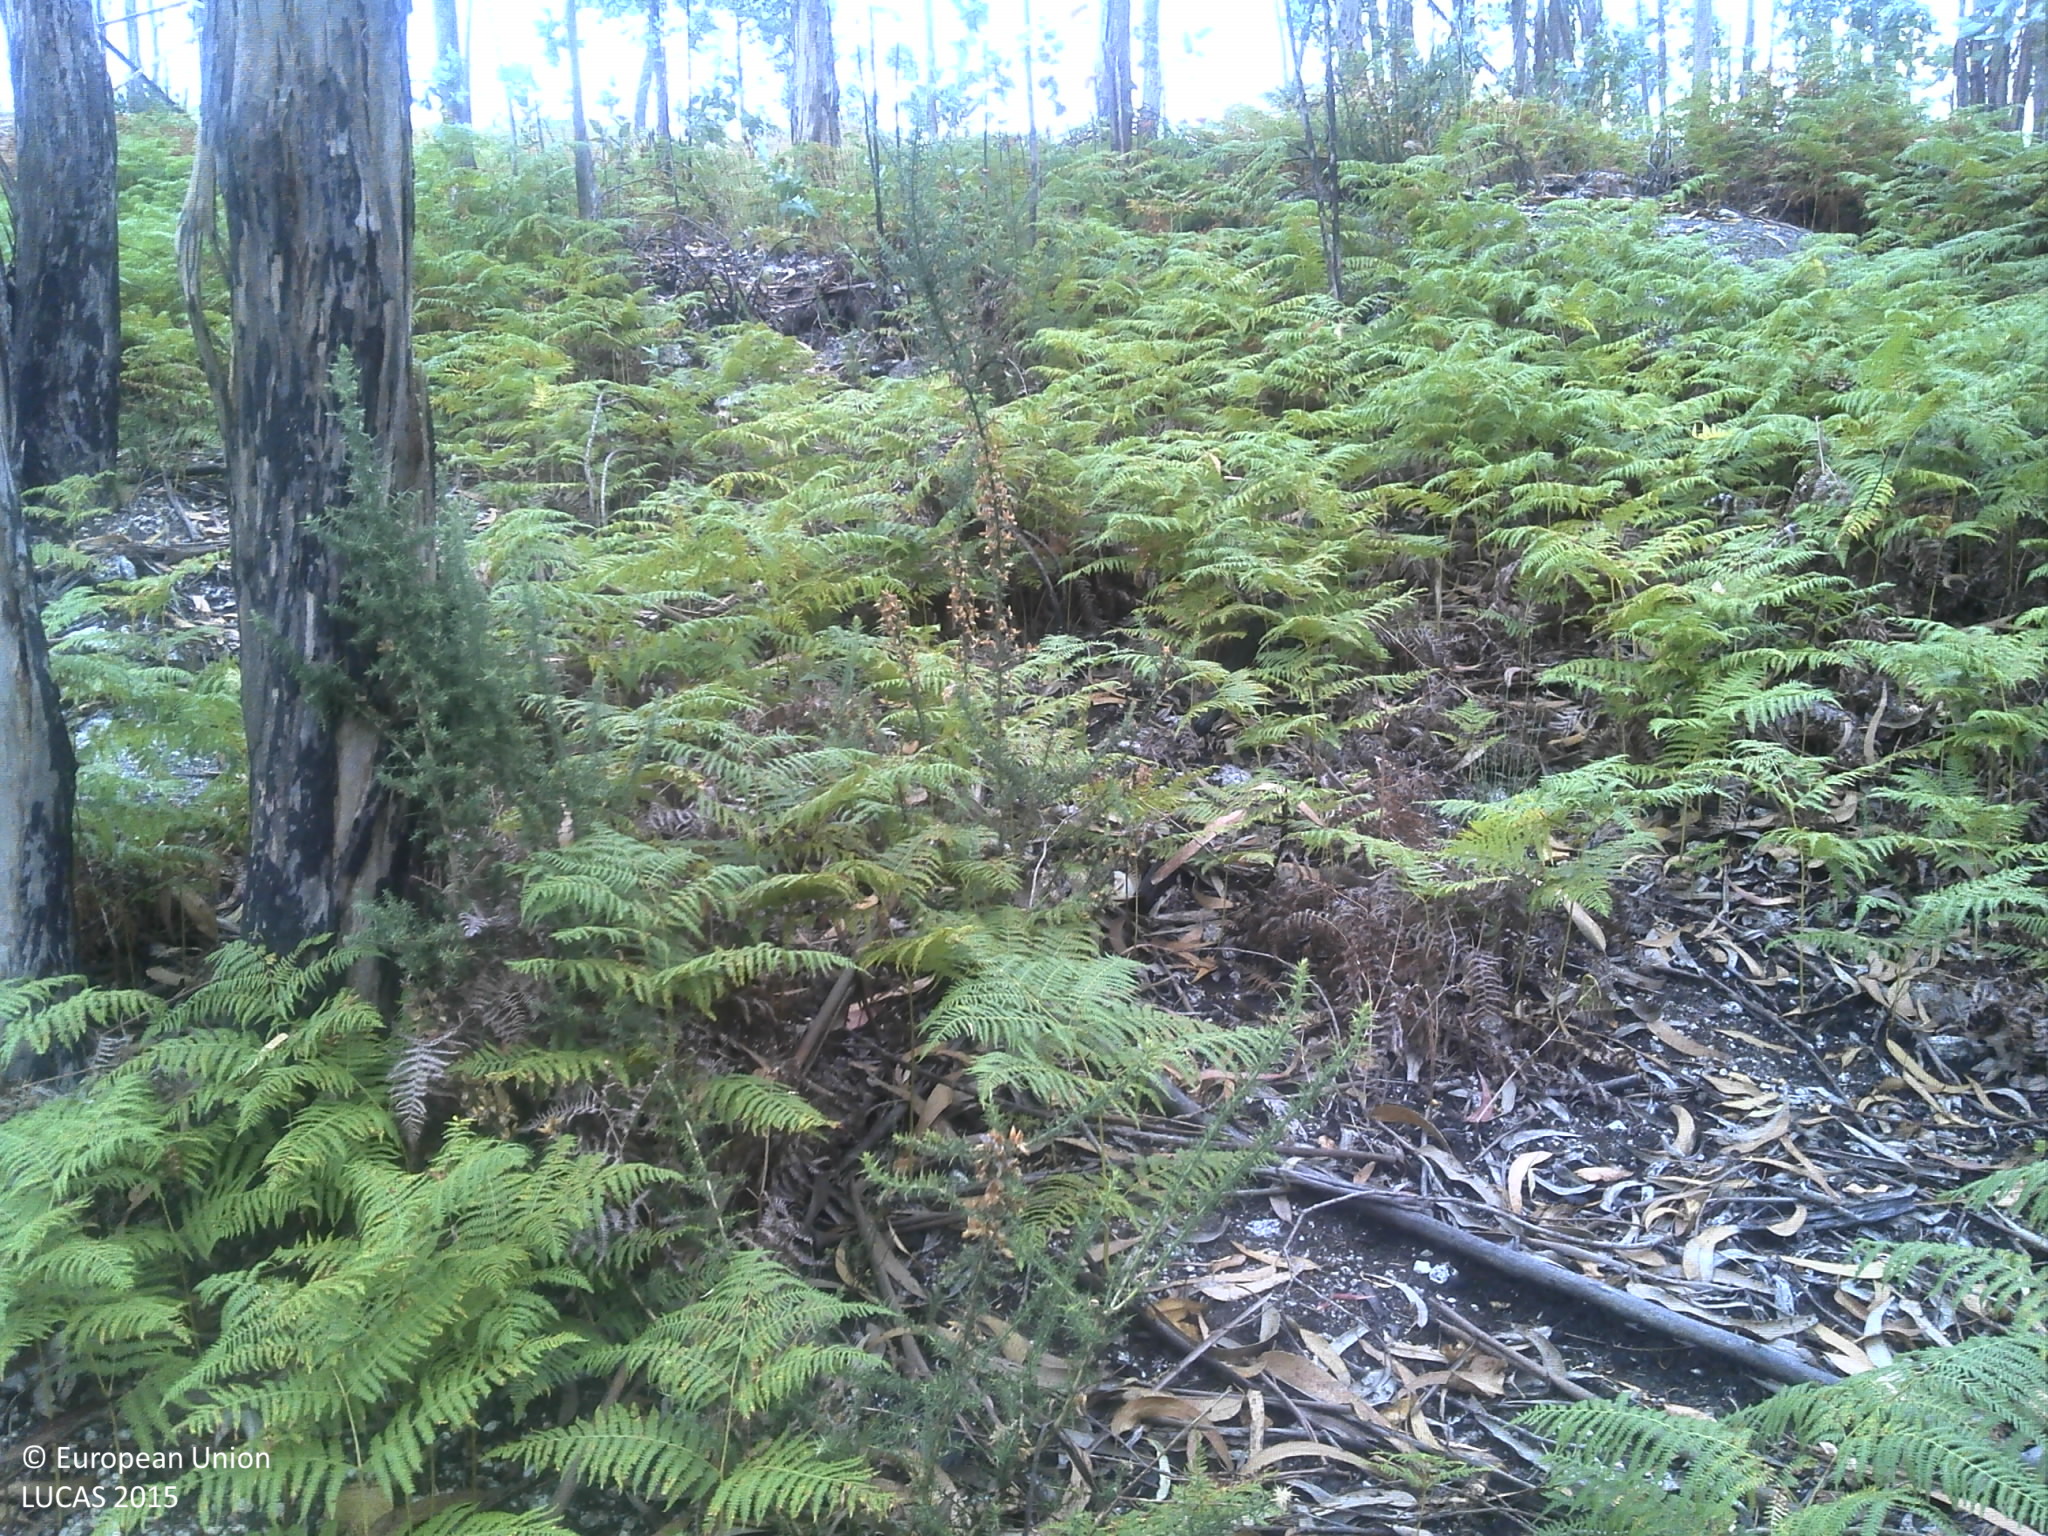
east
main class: Woodland
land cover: Broadleaved woodland
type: exotic forest
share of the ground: 50 - 75 %
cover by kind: broadleaved forest trees 70 %, shrubs 25 %, unconsolidated bare surface 5 %
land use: Forestry
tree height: > 5 m
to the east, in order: Broadleaved woodland; Shrubland without tree cover; Rock outcrops; Electric lines; Shrubland with sparse tree cover; Broadleaved woodland; Tracks; Broadleaved woodland
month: June
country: PT
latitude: 41.2912
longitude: -8.1612
